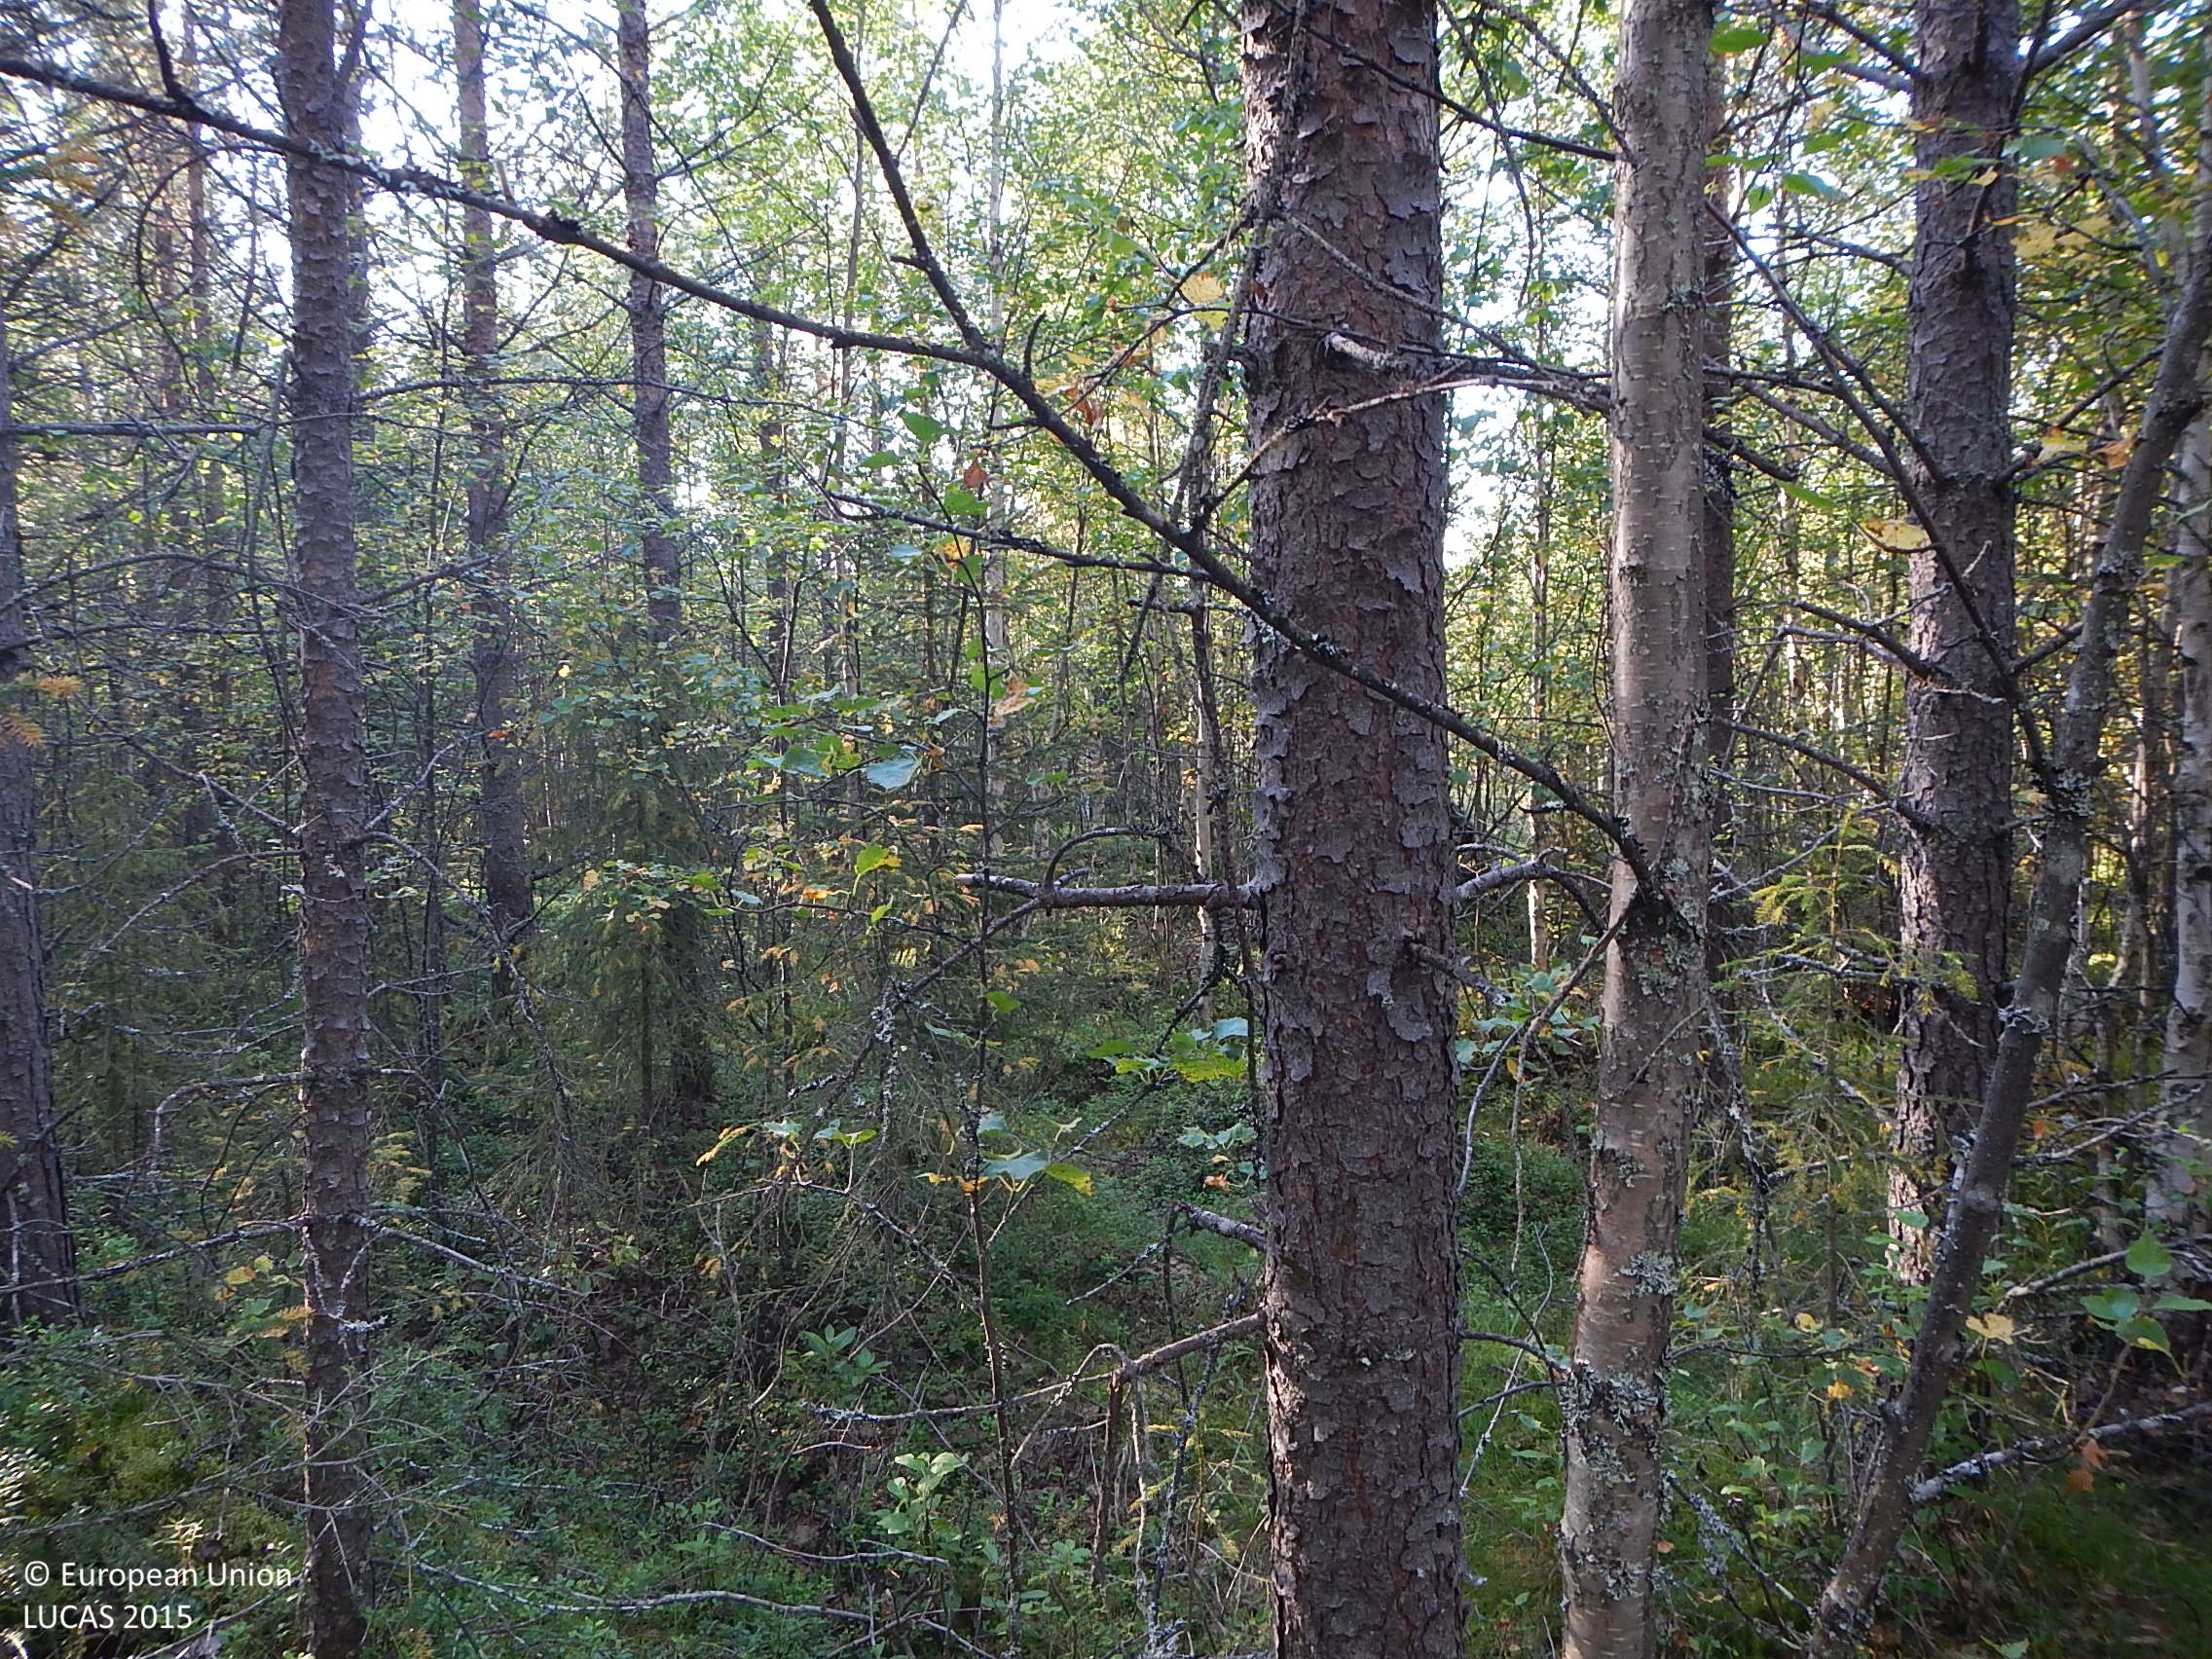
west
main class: Woodland
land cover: Pine dominated mixed woodland
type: boreal forest
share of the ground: > 75 %
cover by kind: coniferous forest trees 60 %, broadleaved forest trees 20 %, shrubs 10 %, herbaceous plants 5 %, lichens and mosses 5 %
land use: Forestry
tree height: > 5 m
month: August
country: FI
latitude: 66.4029
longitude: 28.2963
